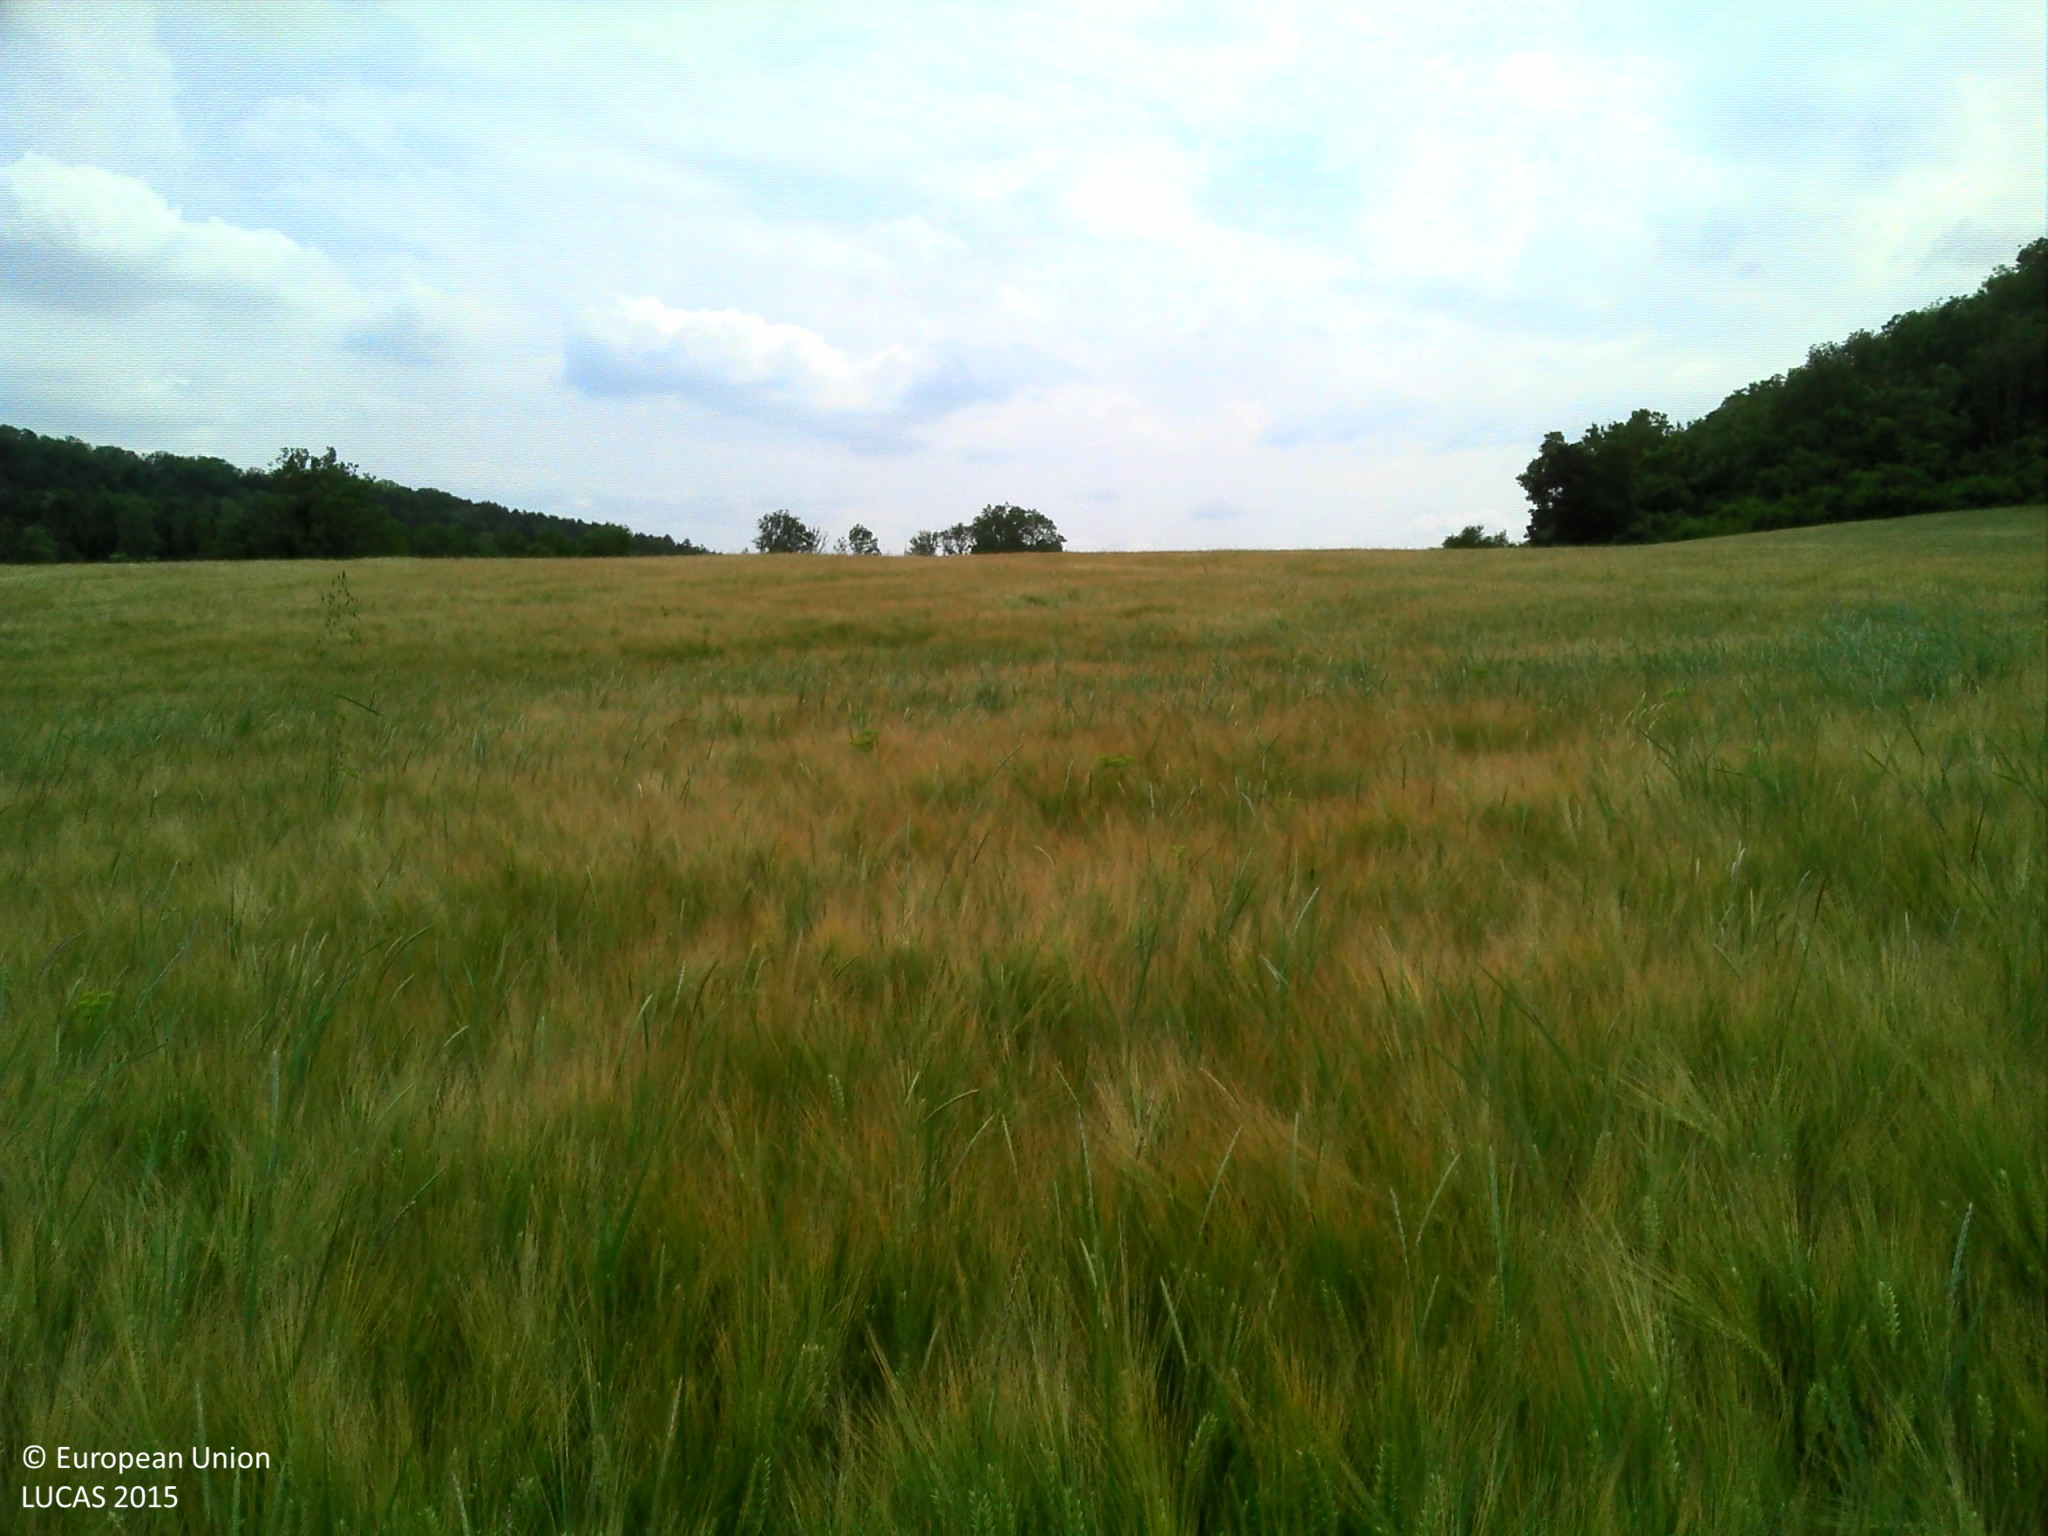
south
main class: Cropland
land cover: Barley
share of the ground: > 75 %
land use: Agriculture (excluding fallow land and kitchen gardens)
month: June
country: FR
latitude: 48.5200
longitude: 6.2499
